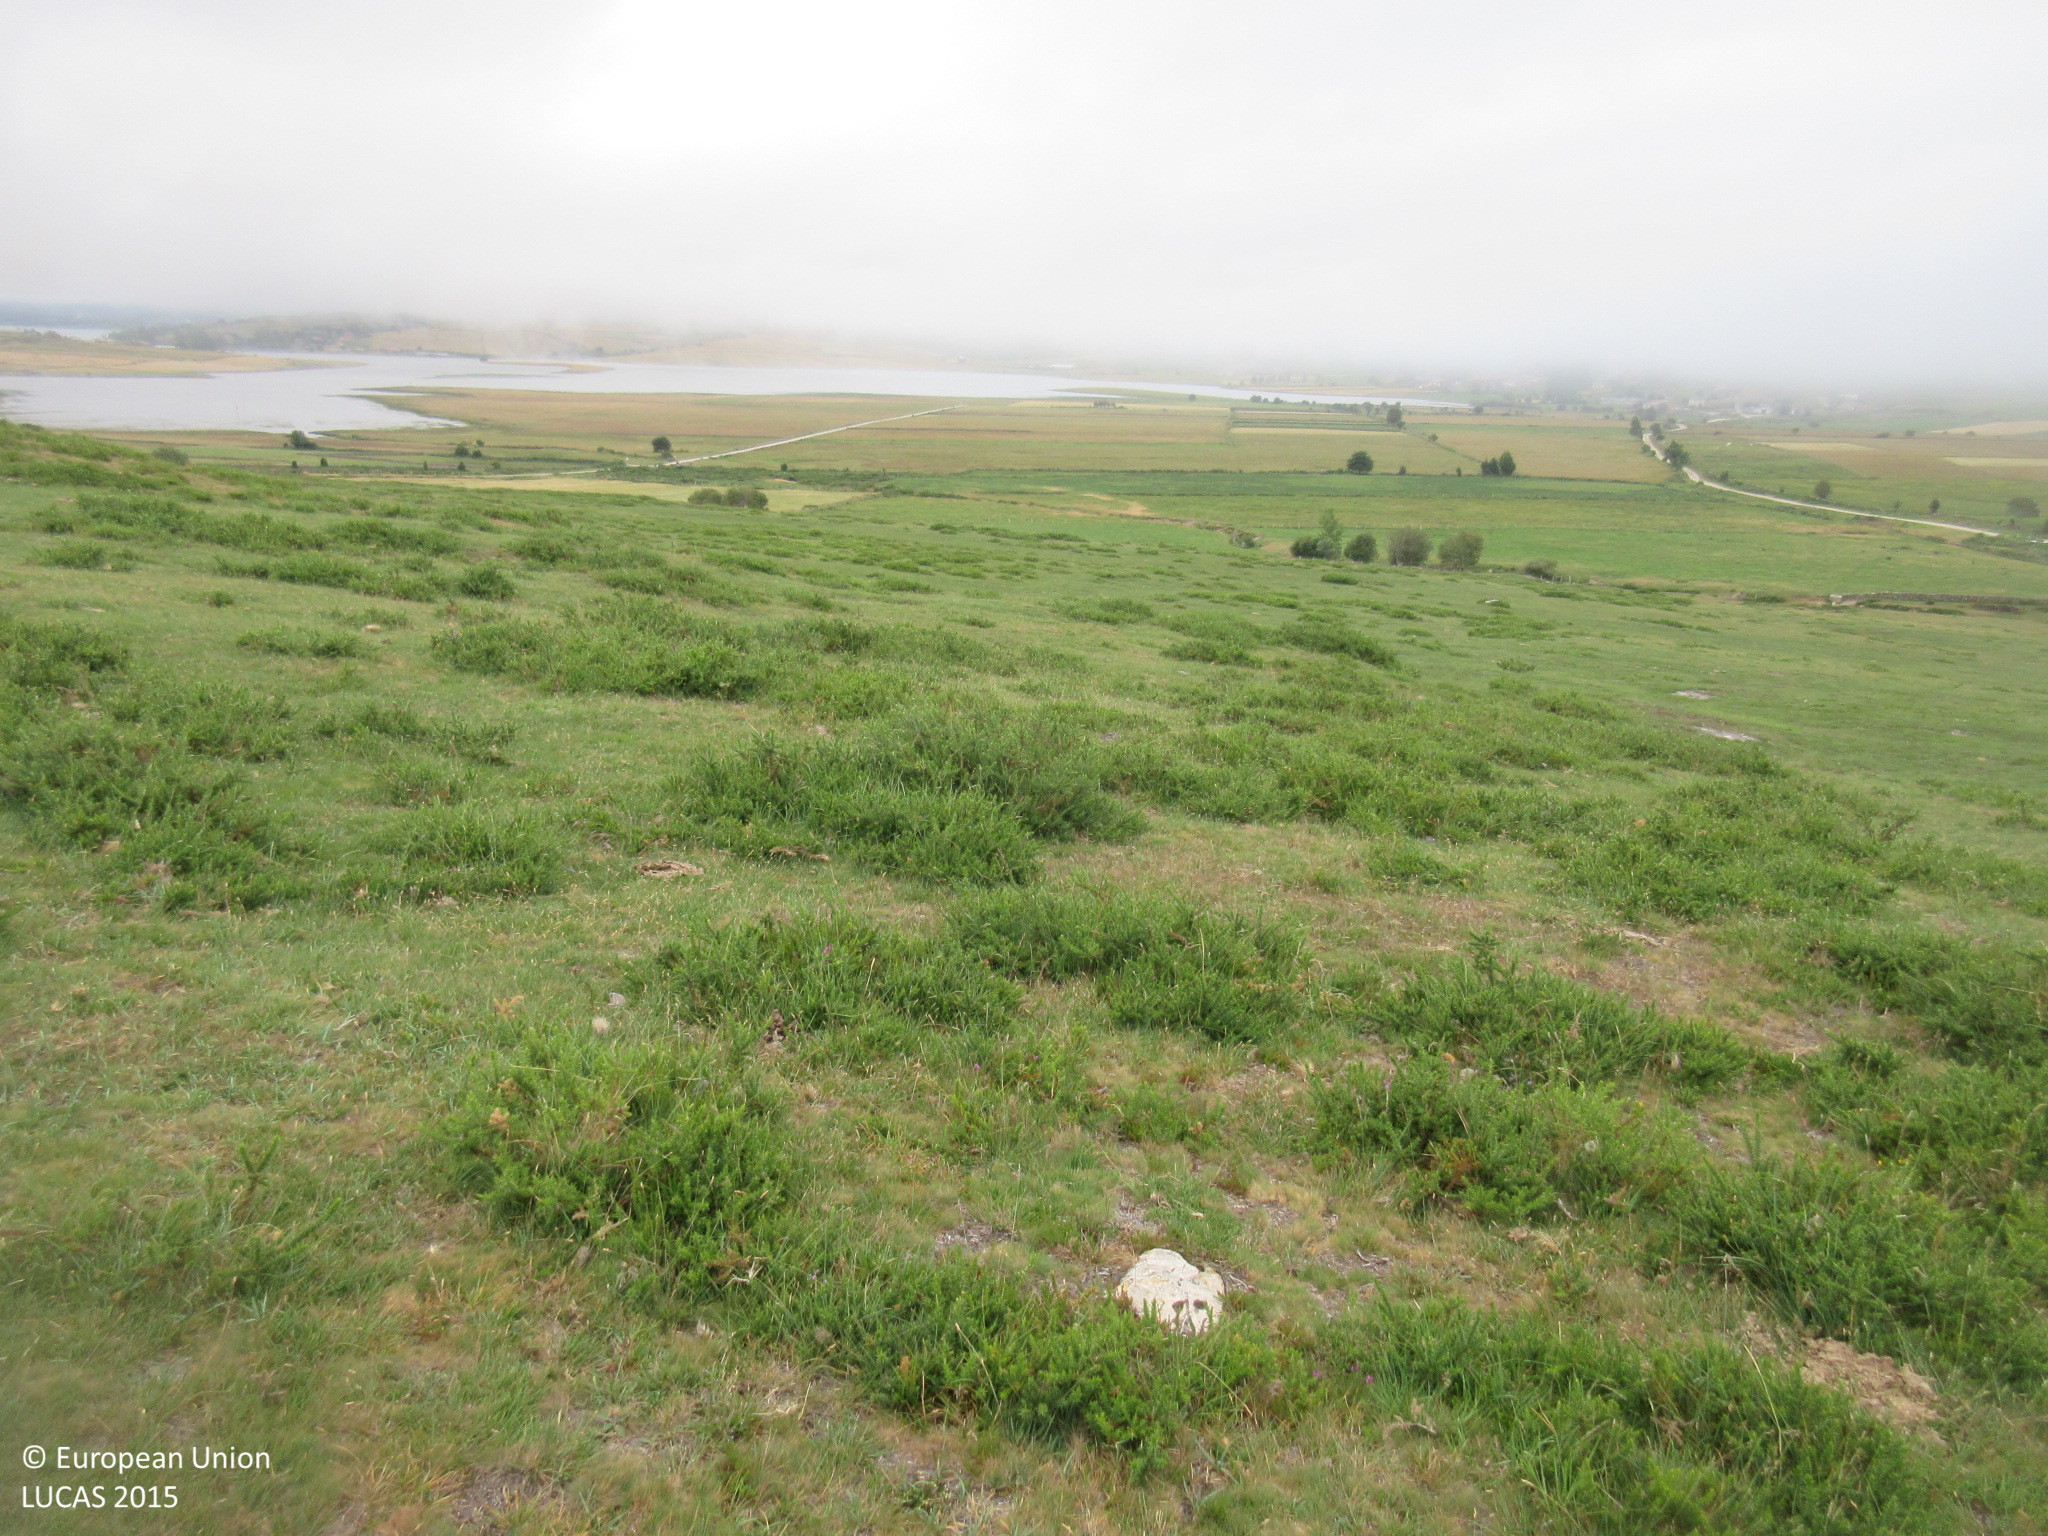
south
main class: Grassland
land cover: Grassland without tree/shrub cover
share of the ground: > 75 %
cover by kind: herbaceous plants 95 %, shrubs 5 %
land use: Agriculture (excluding fallow land and kitchen gardens)
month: July
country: ES
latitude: 43.0543
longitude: -3.9582
